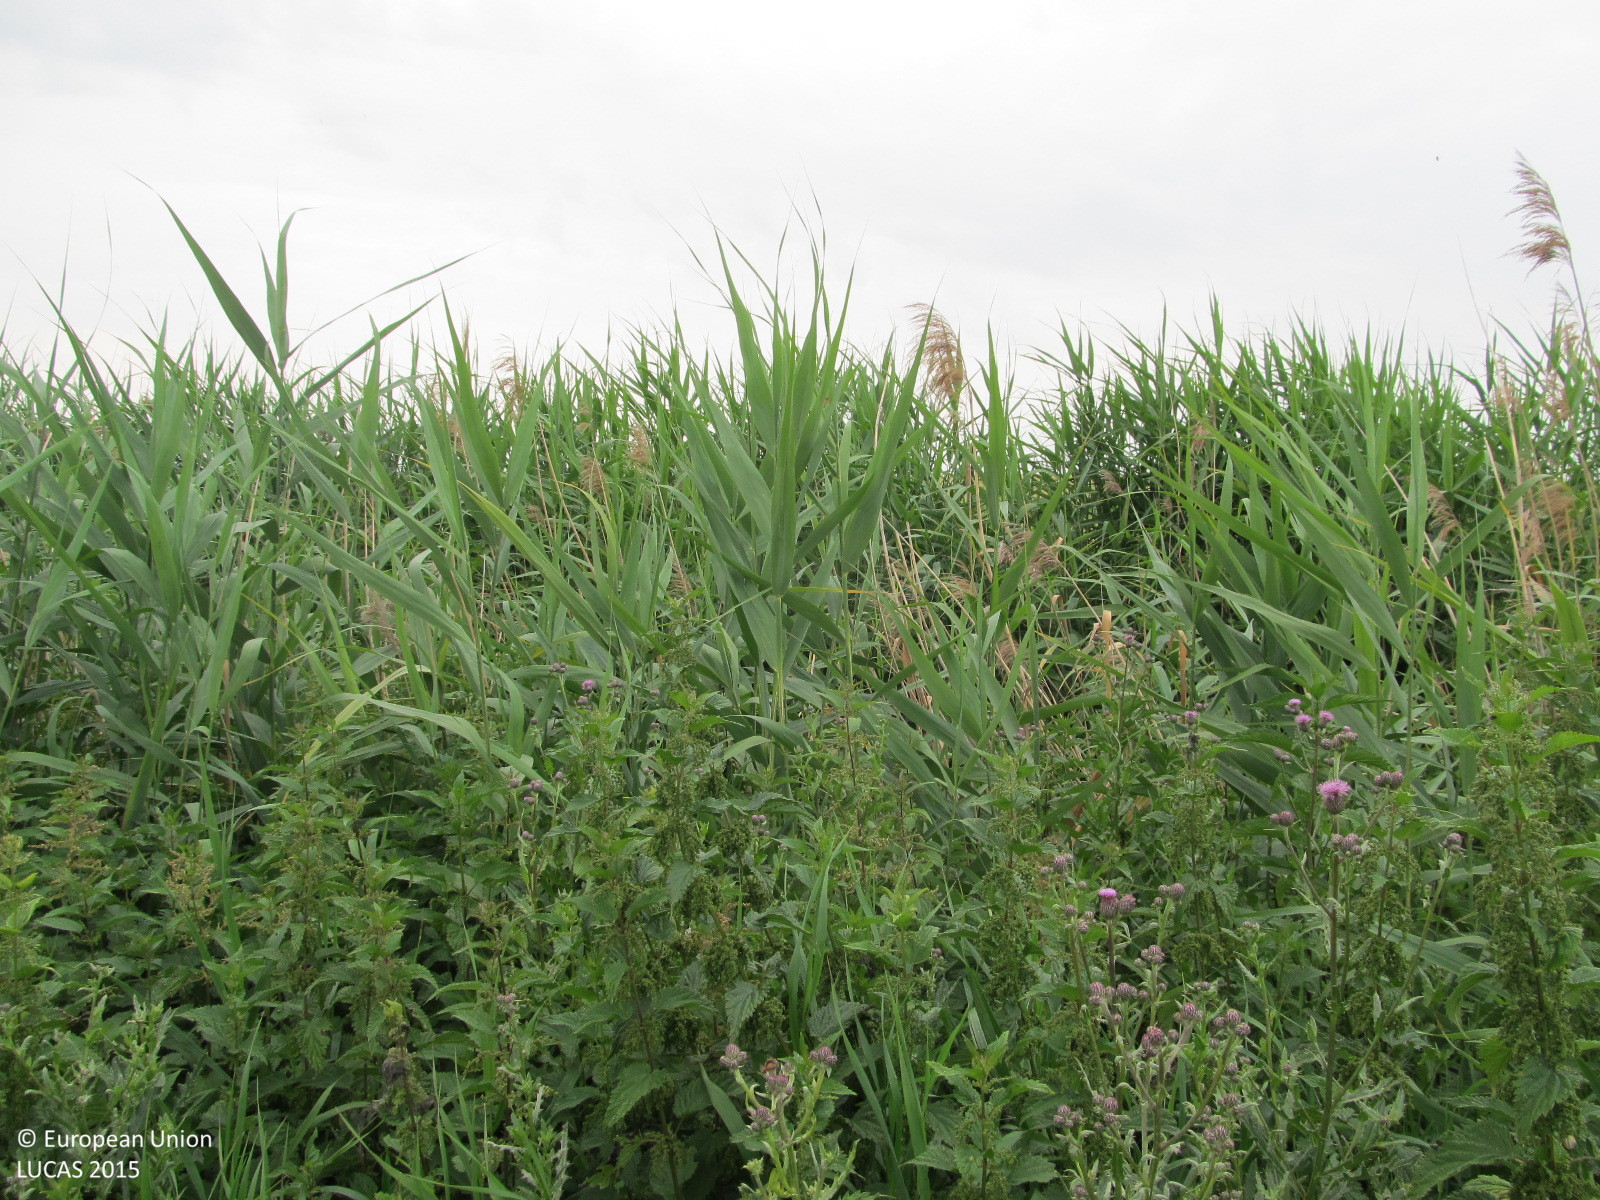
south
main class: Cropland
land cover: Barley
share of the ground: > 75 %
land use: Agriculture (excluding fallow land and kitchen gardens)
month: June
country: AT
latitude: 48.6066
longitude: 15.9036
